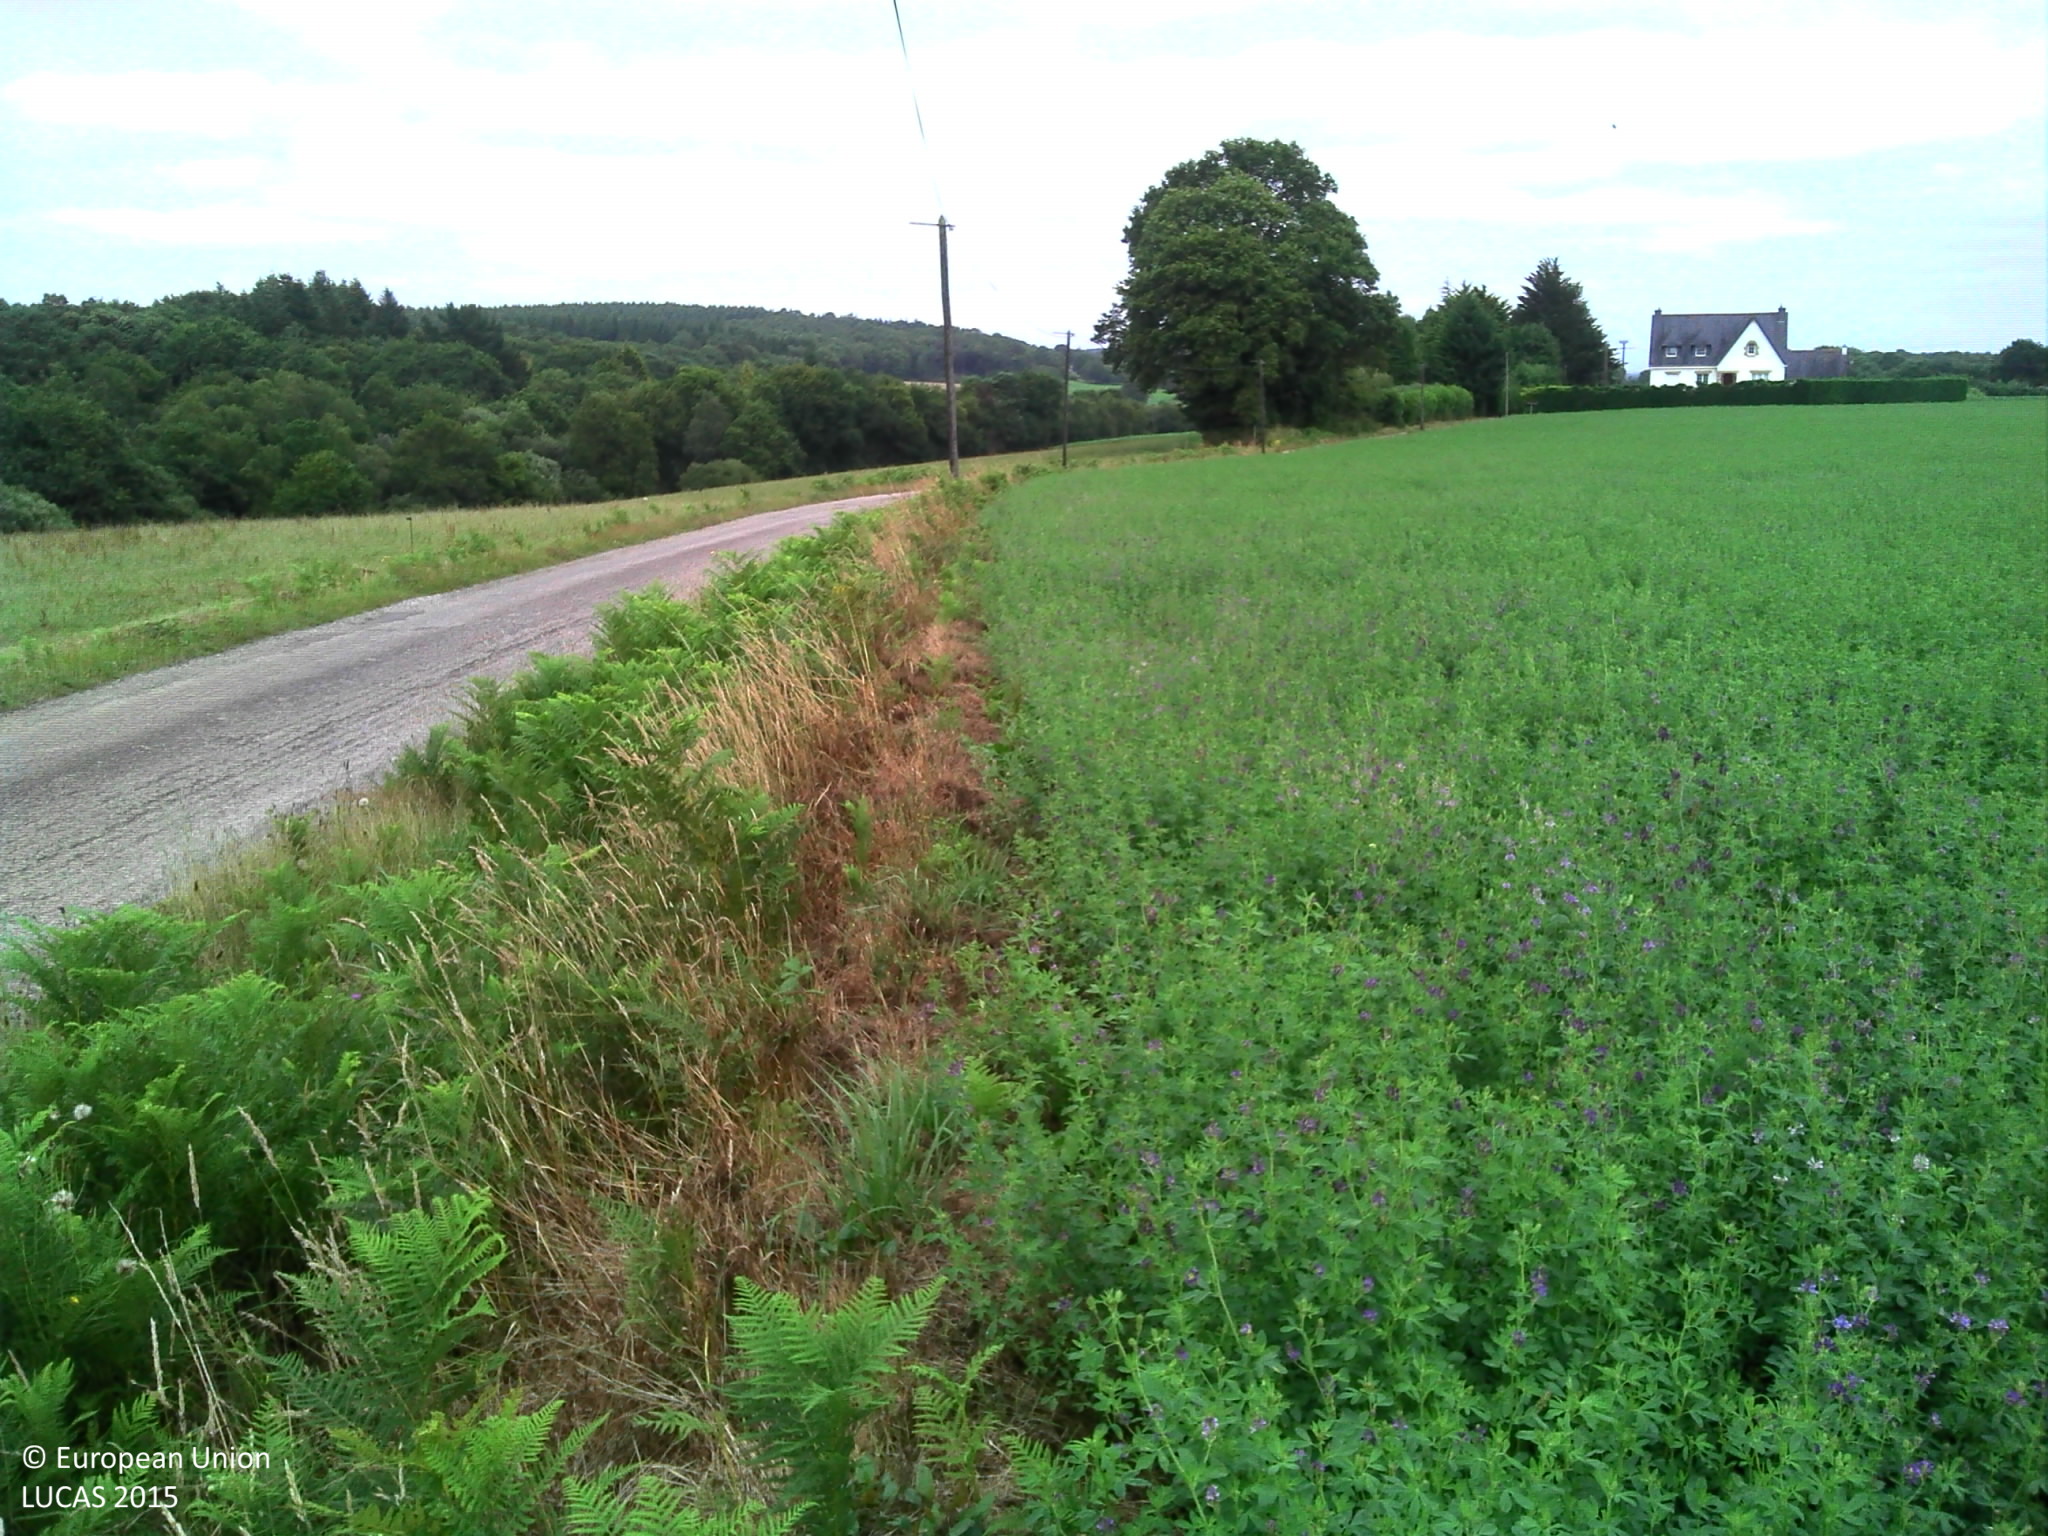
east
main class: Cropland
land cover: Lucerne
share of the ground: > 75 %
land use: Agriculture (excluding fallow land and kitchen gardens)
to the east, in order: Lucerne; Electric lines; Lucerne; Artificial constructions in urban areas
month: July
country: FR
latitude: 47.8134
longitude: -3.0075
